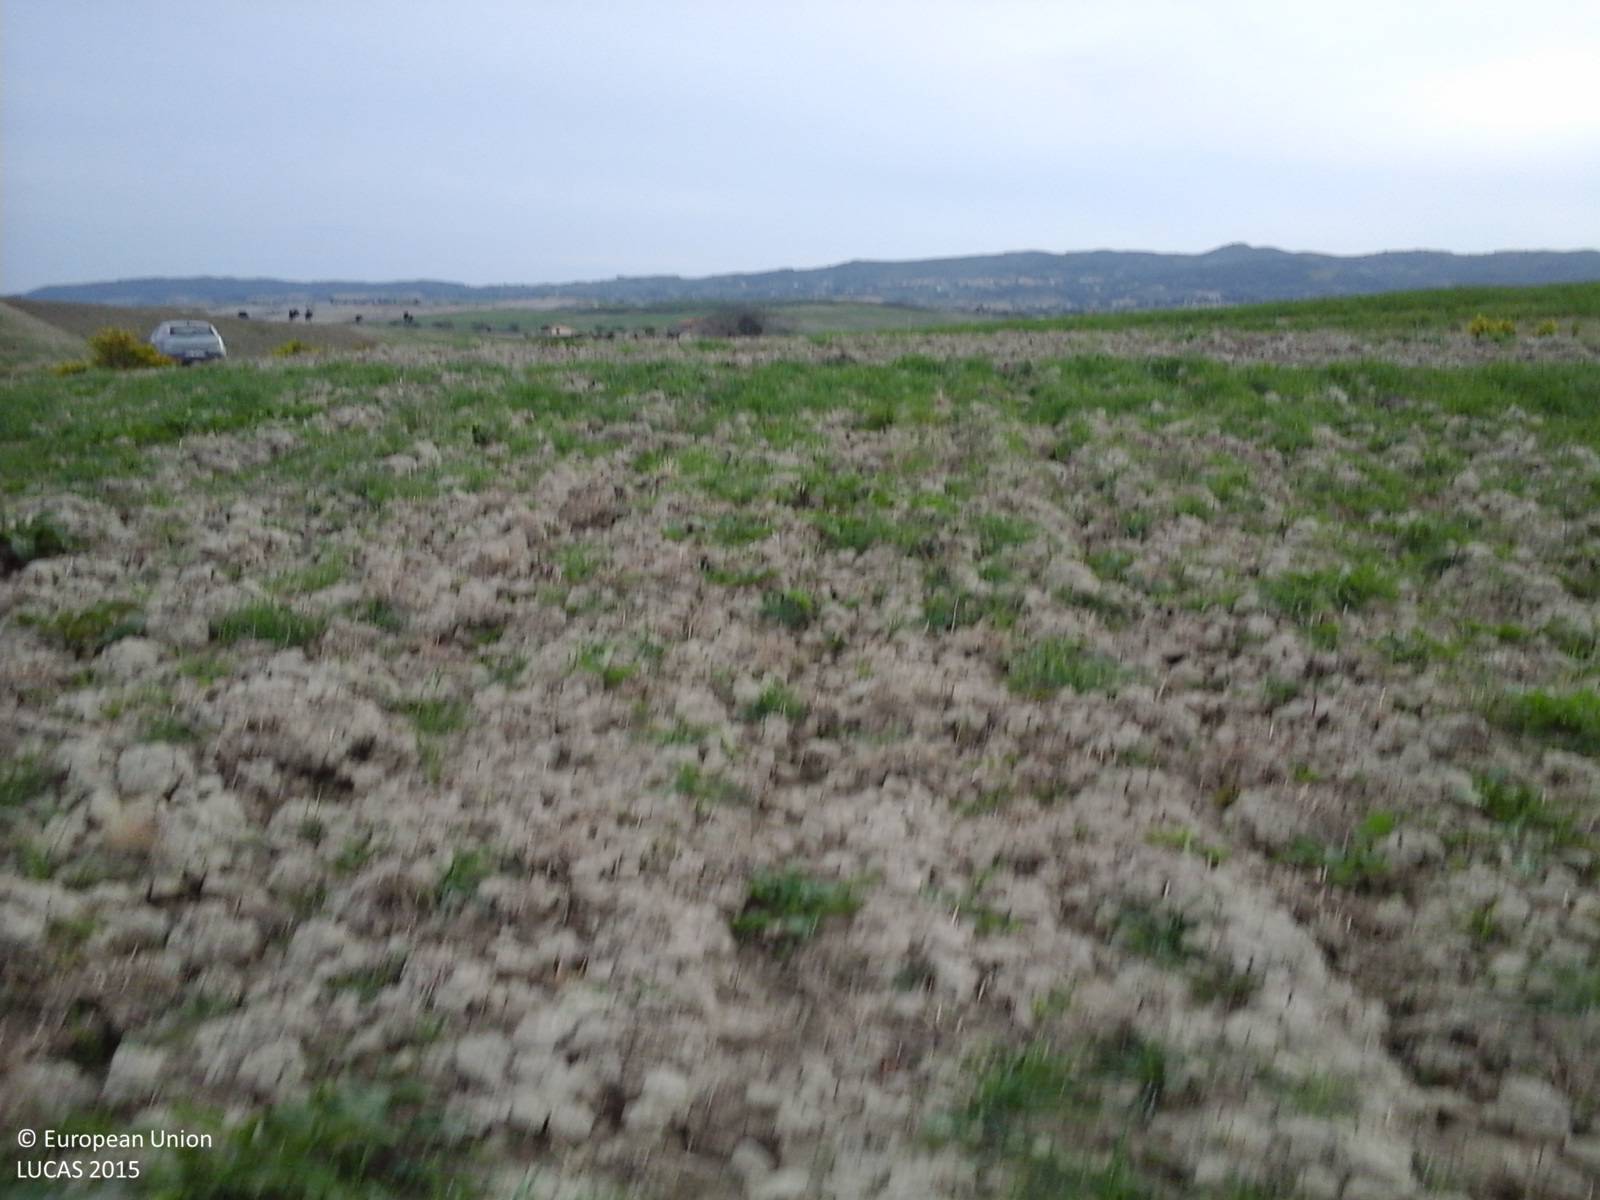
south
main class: Grassland
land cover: Grassland without tree/shrub cover
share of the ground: > 75 %
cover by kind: herbaceous plants 100 %
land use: Agriculture (excluding fallow land and kitchen gardens)
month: October
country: IT
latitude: 43.4834
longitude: 10.4808
